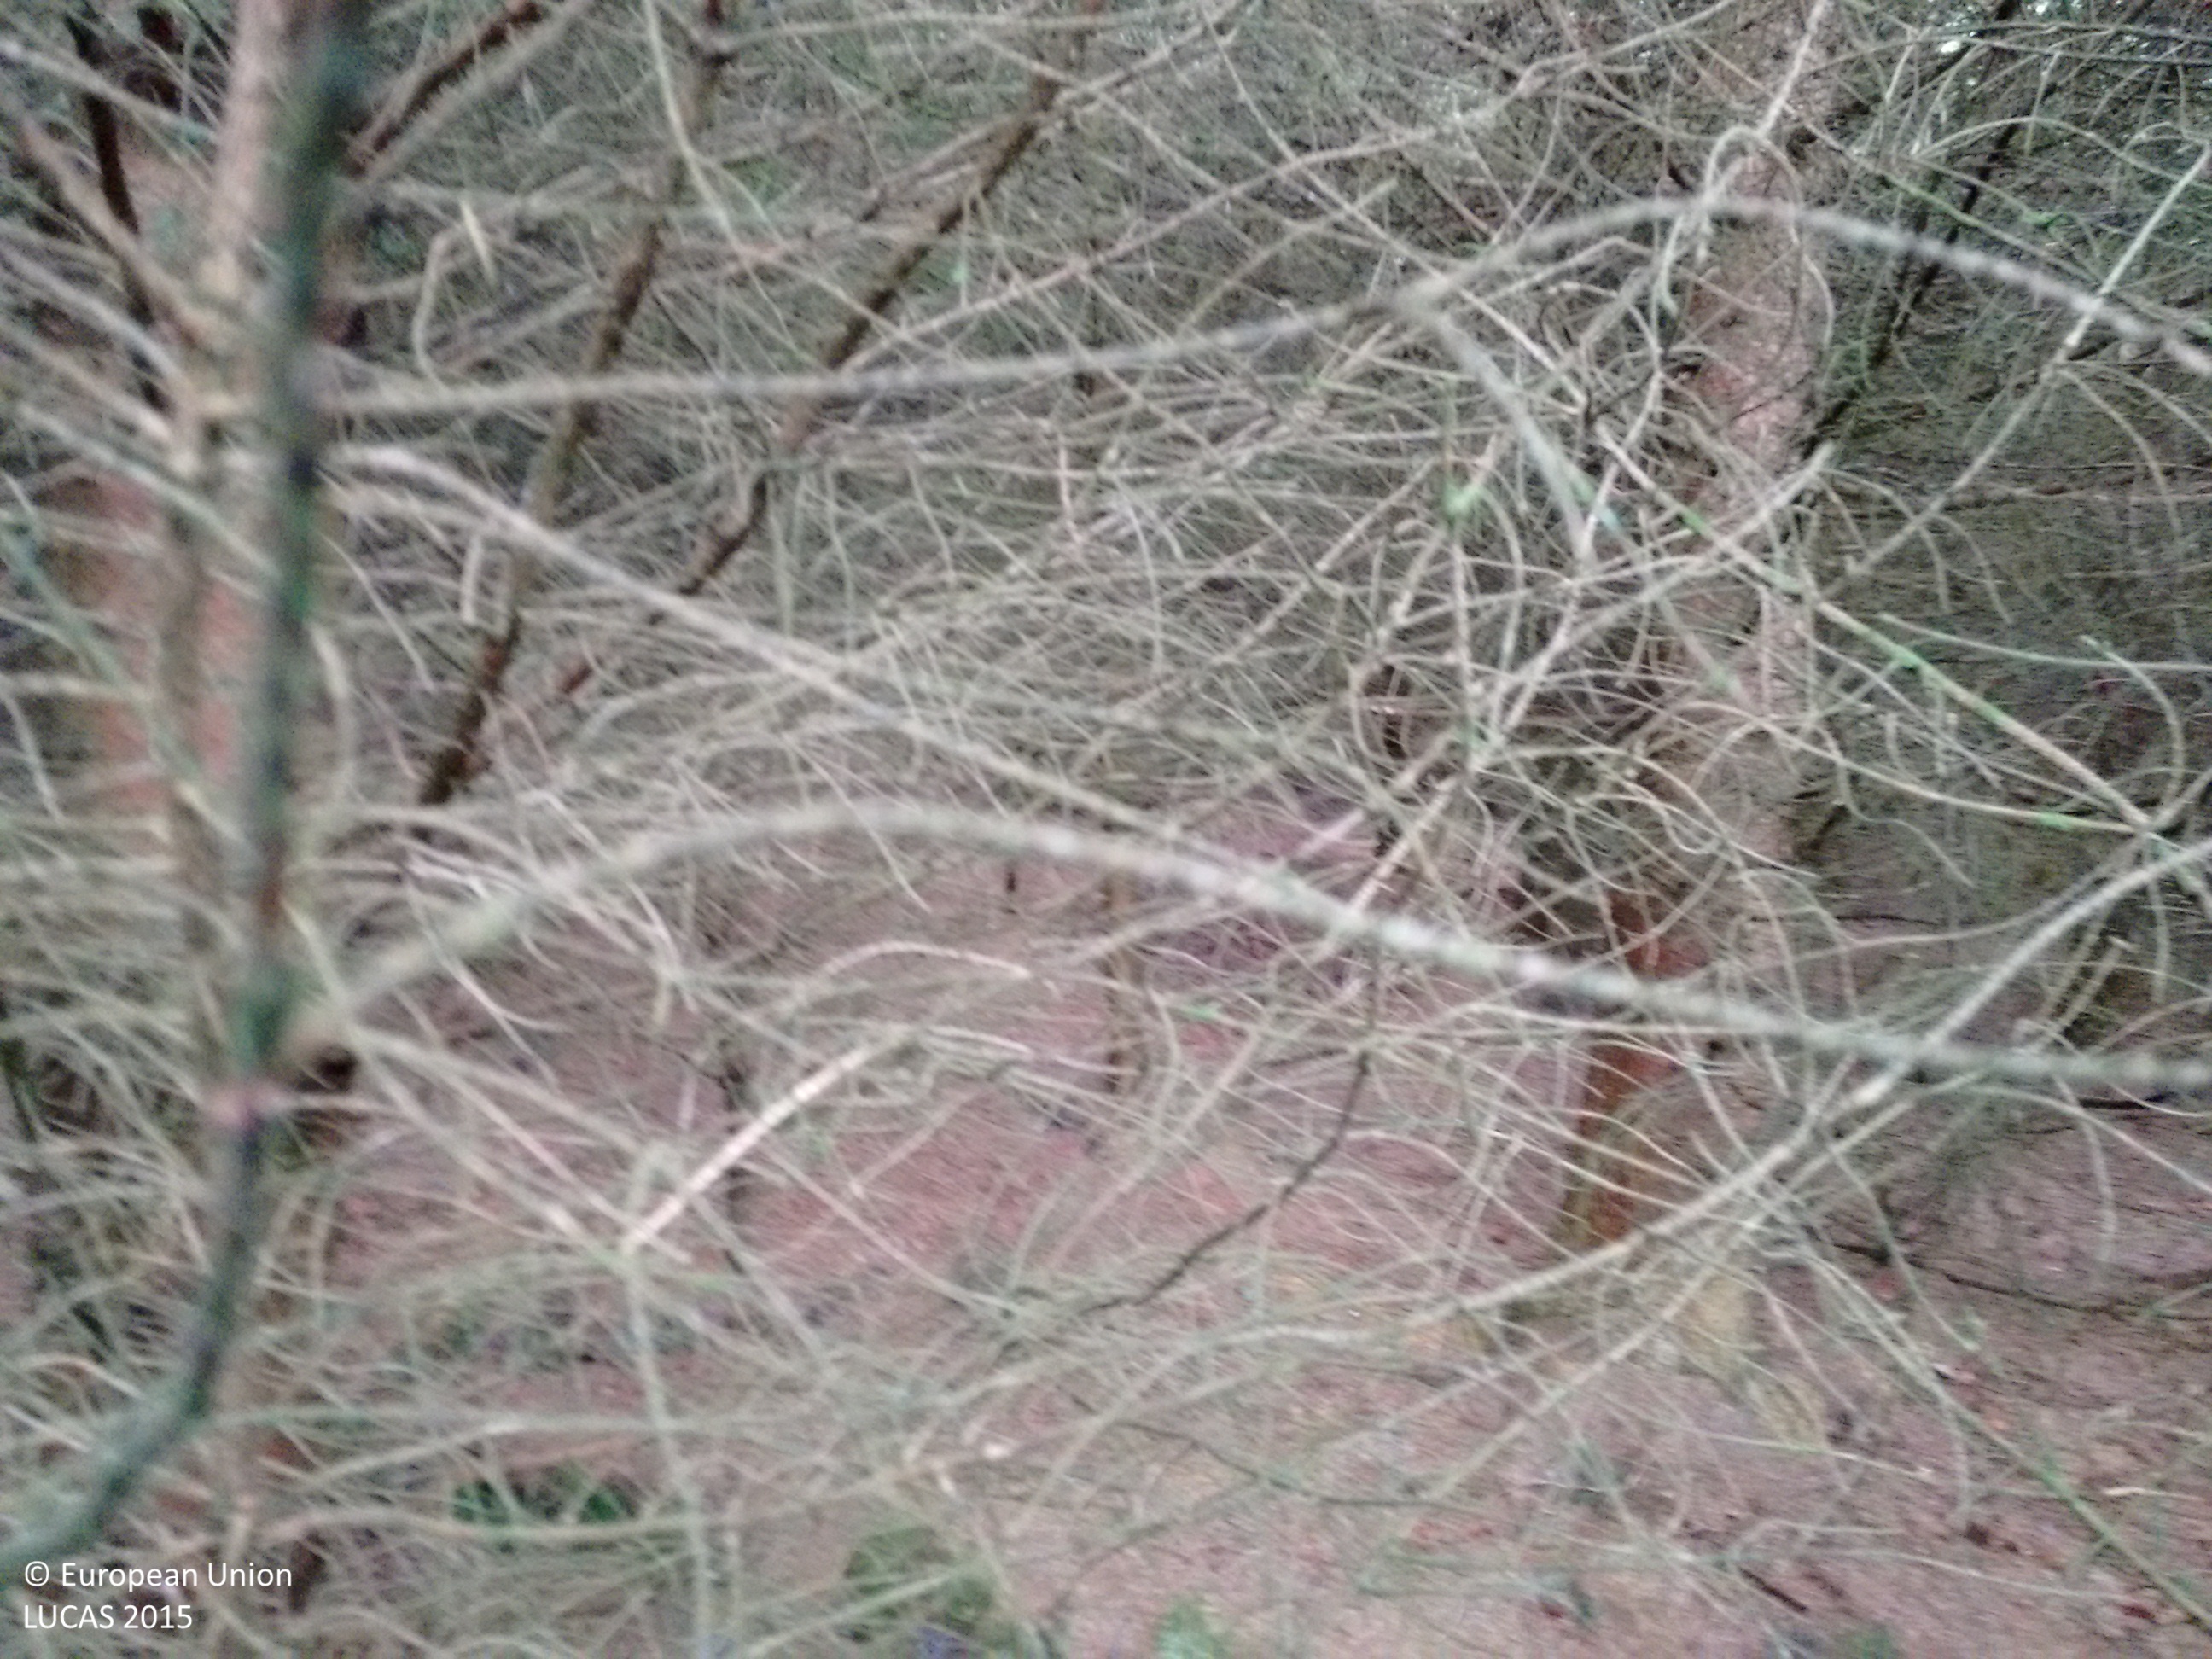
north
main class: Woodland
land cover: Spruce dominated coniferous woodland
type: exotic forest
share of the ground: > 75 %
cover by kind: coniferous forest trees 100 %
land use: Forestry
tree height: > 5 m
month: September
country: IE
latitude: 55.0210
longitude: -7.4030
